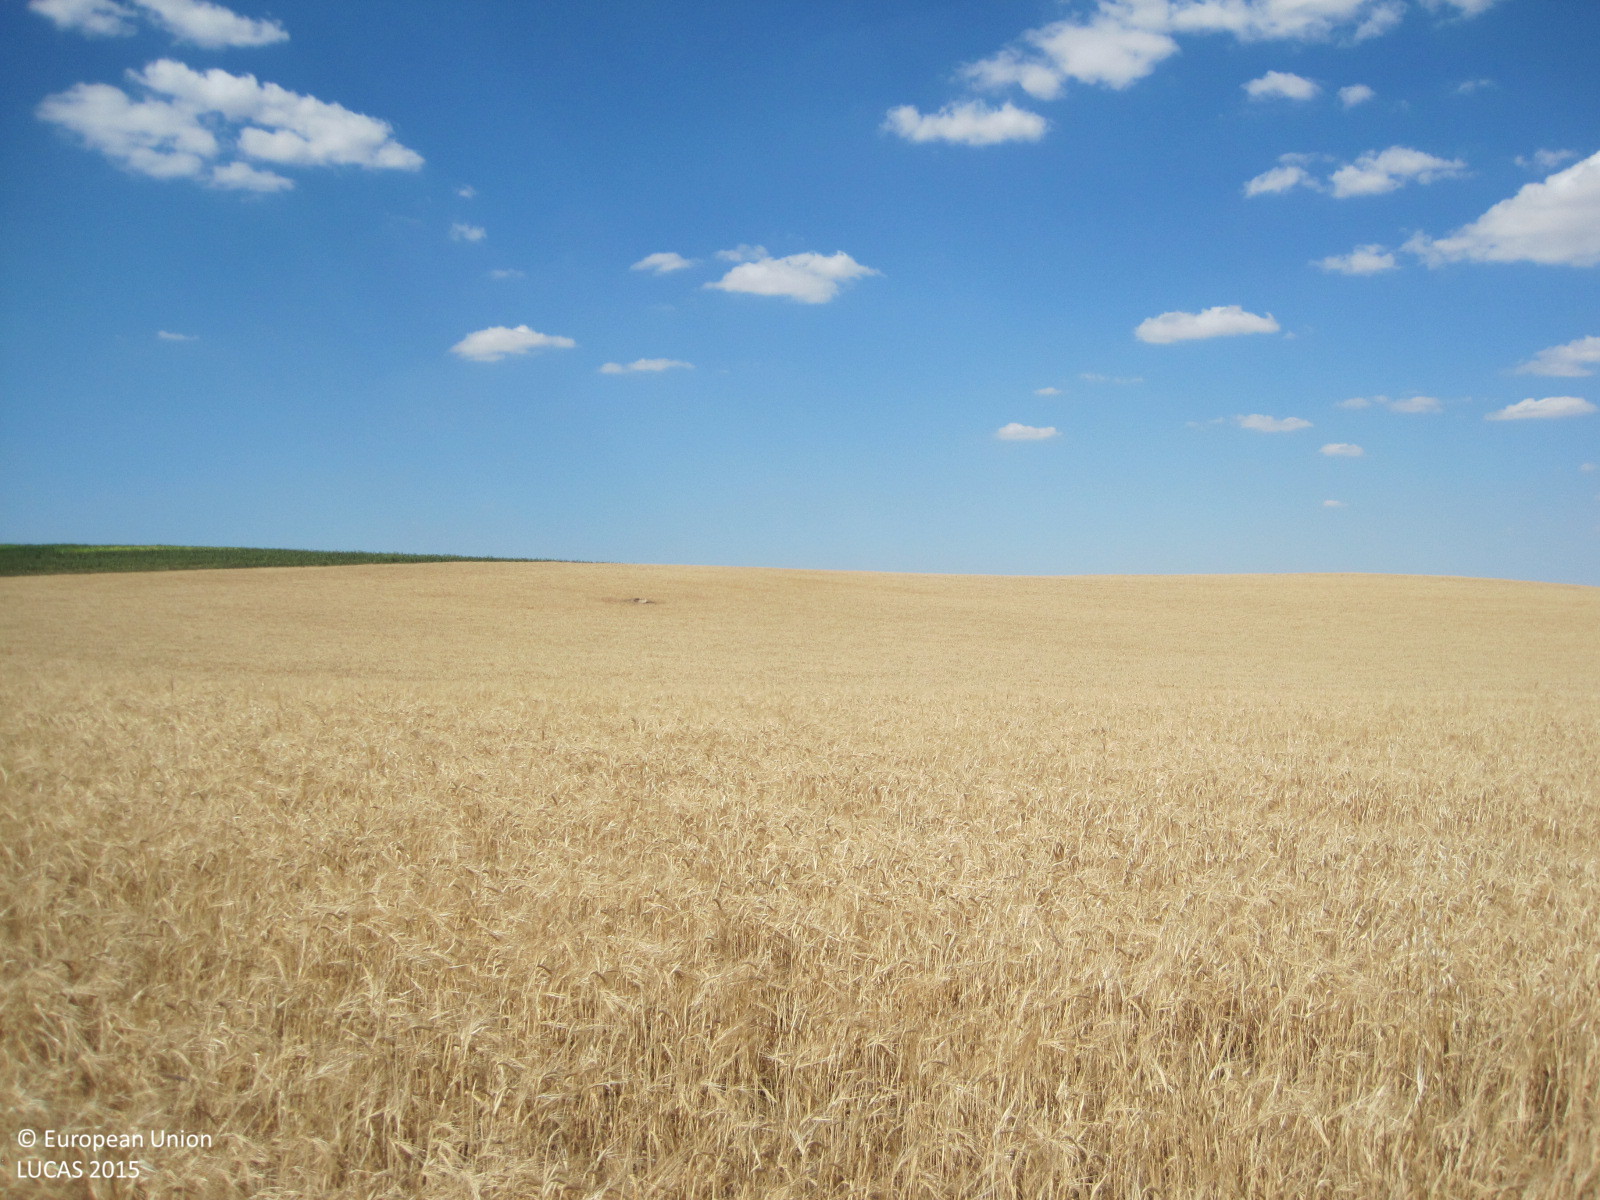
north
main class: Cropland
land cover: Barley
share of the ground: > 75 %
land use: Agriculture (excluding fallow land and kitchen gardens)
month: June
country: ES
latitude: 39.9177
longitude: -4.2530
